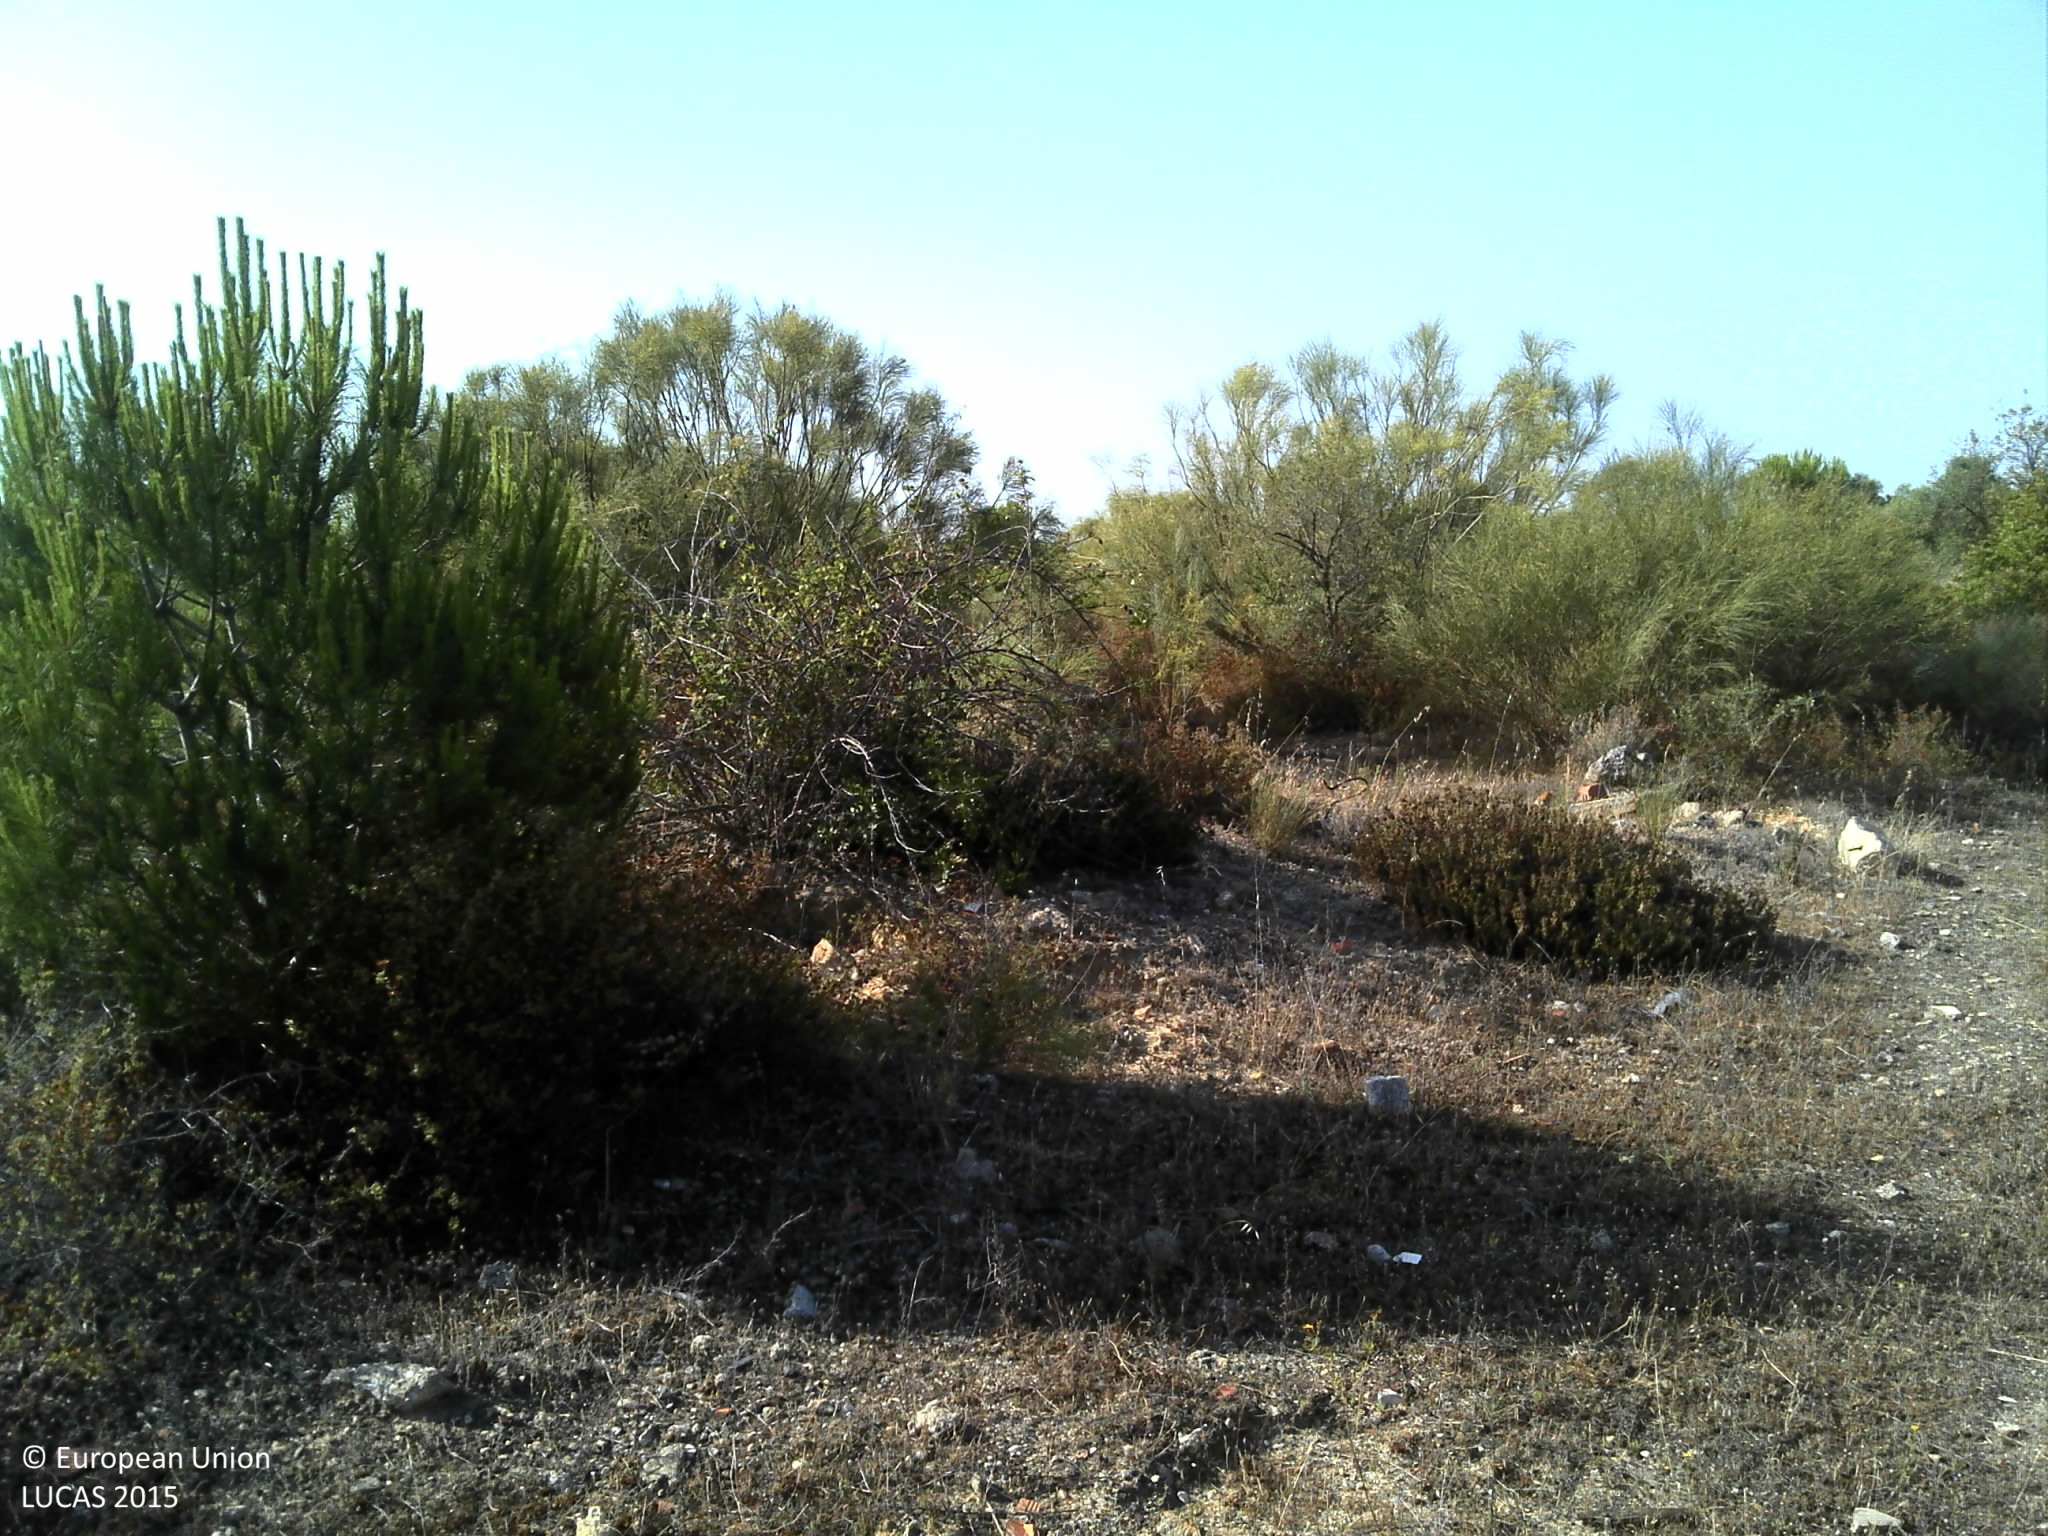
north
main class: Grassland
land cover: Grassland with sparse tree/shrub cover
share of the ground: 25 - 50 %
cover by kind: unconsolidated bare surface 60 %, herbaceous plants 30 %, broadleaved forest trees 5 %, shrubs 5 %
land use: Abandoned areas
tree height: < 5 m
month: June
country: PT
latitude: 38.6337
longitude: -9.0839
